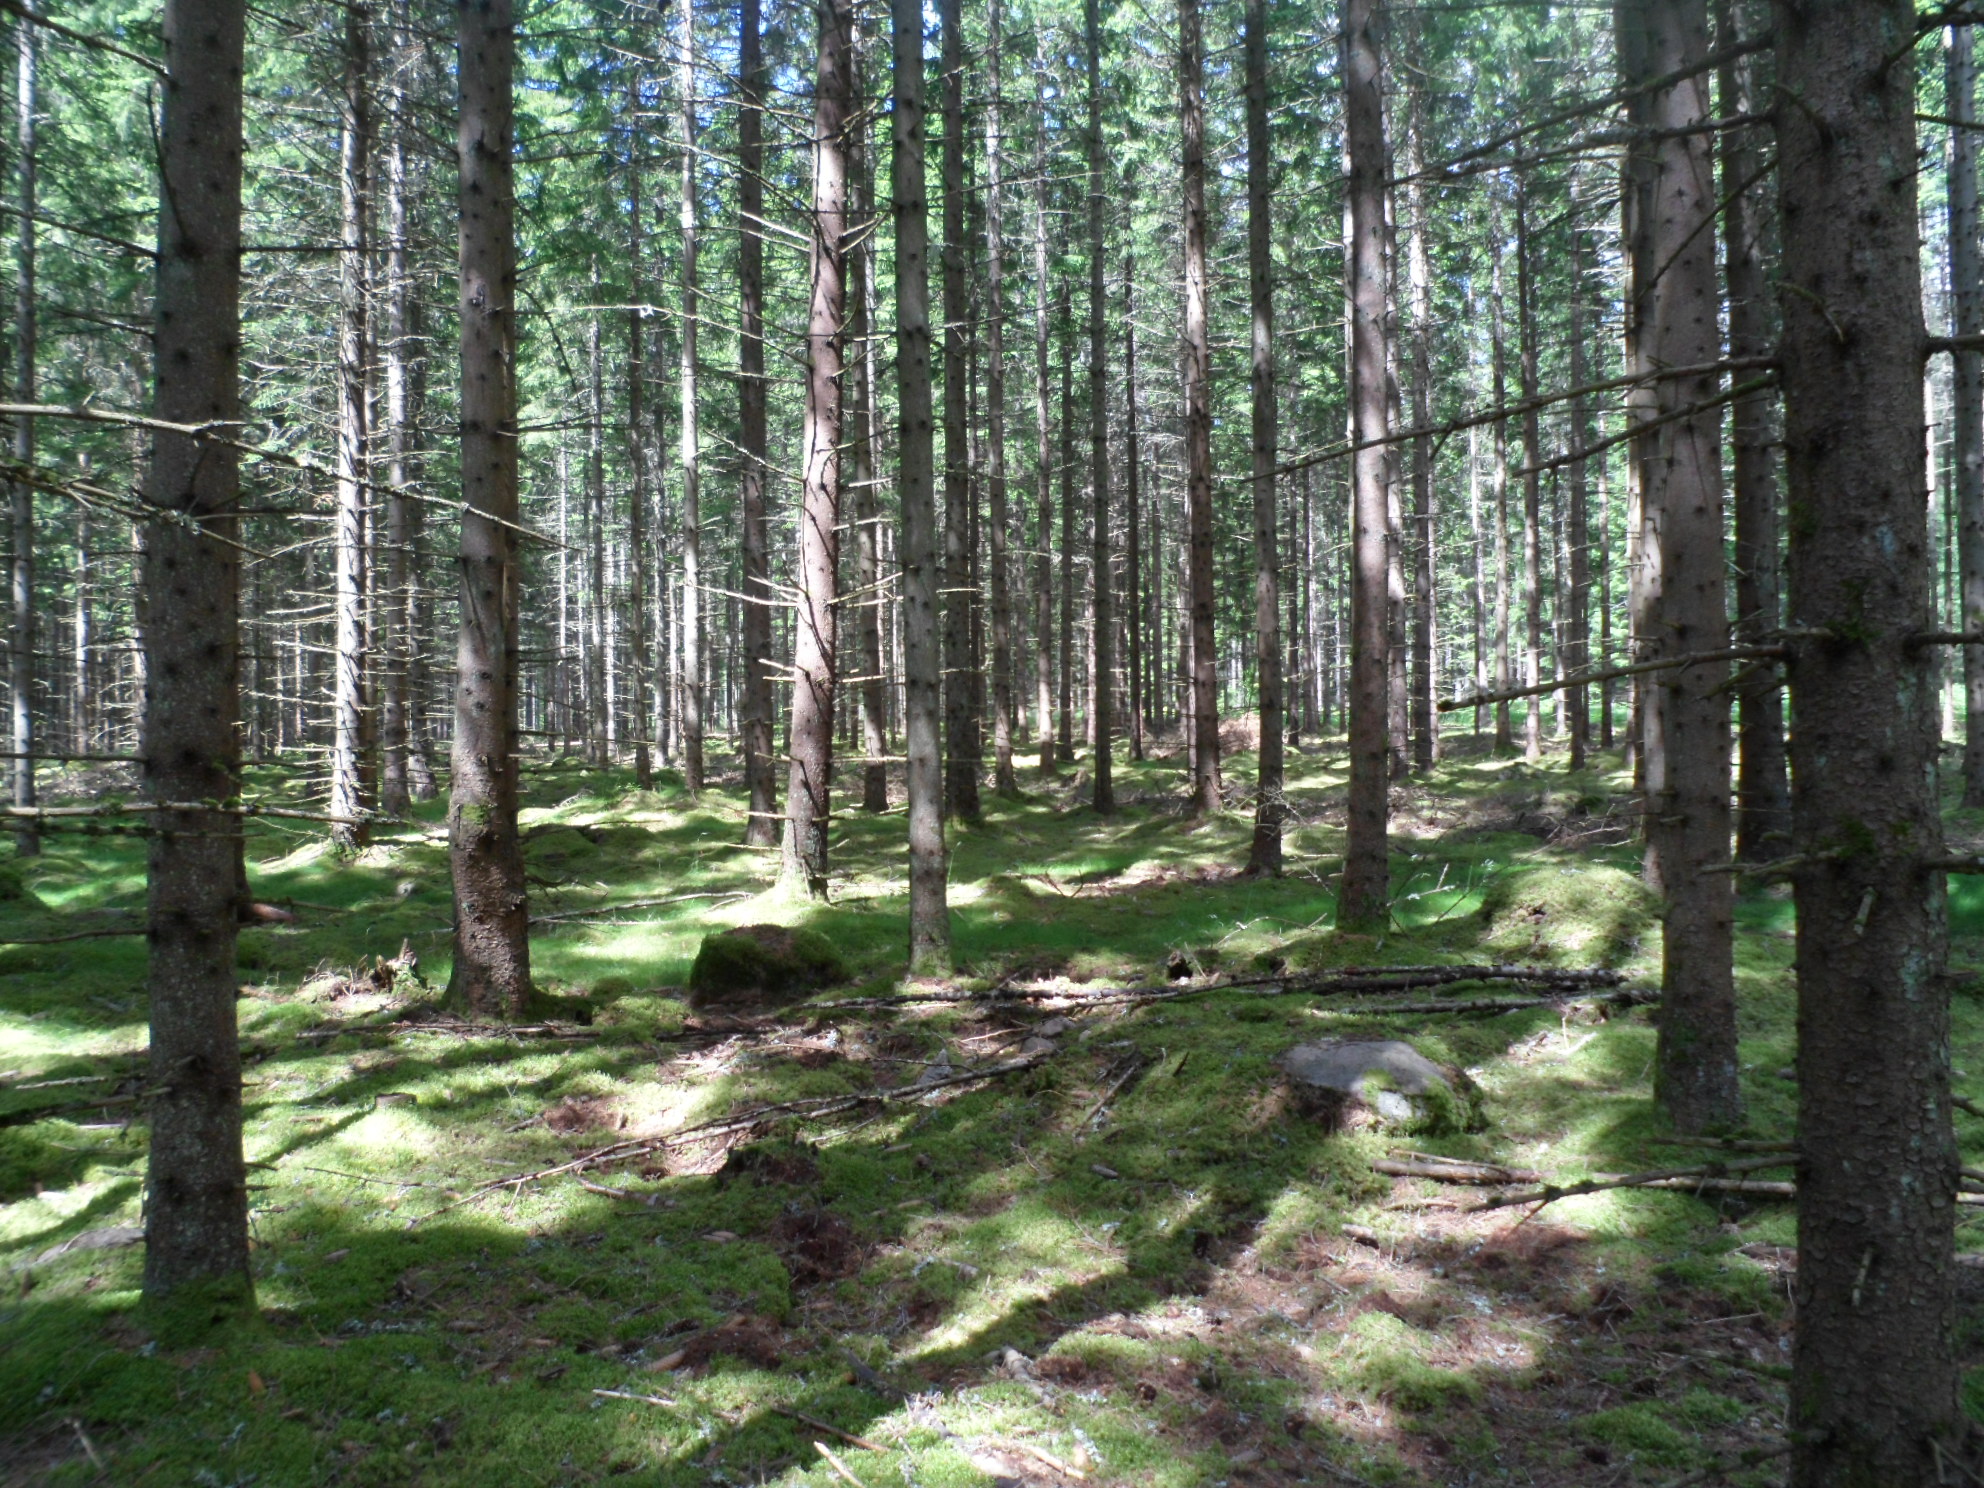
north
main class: Woodland
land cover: Spruce dominated coniferous woodland
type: boreal forest
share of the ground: 50 - 75 %
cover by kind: coniferous forest trees 65 %, lichens and mosses 20 %, shrubs 10 %, unconsolidated bare surface 5 %
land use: Forestry
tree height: > 5 m
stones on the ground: < 10 %
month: June
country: SE
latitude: 57.1080
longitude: 14.7682
